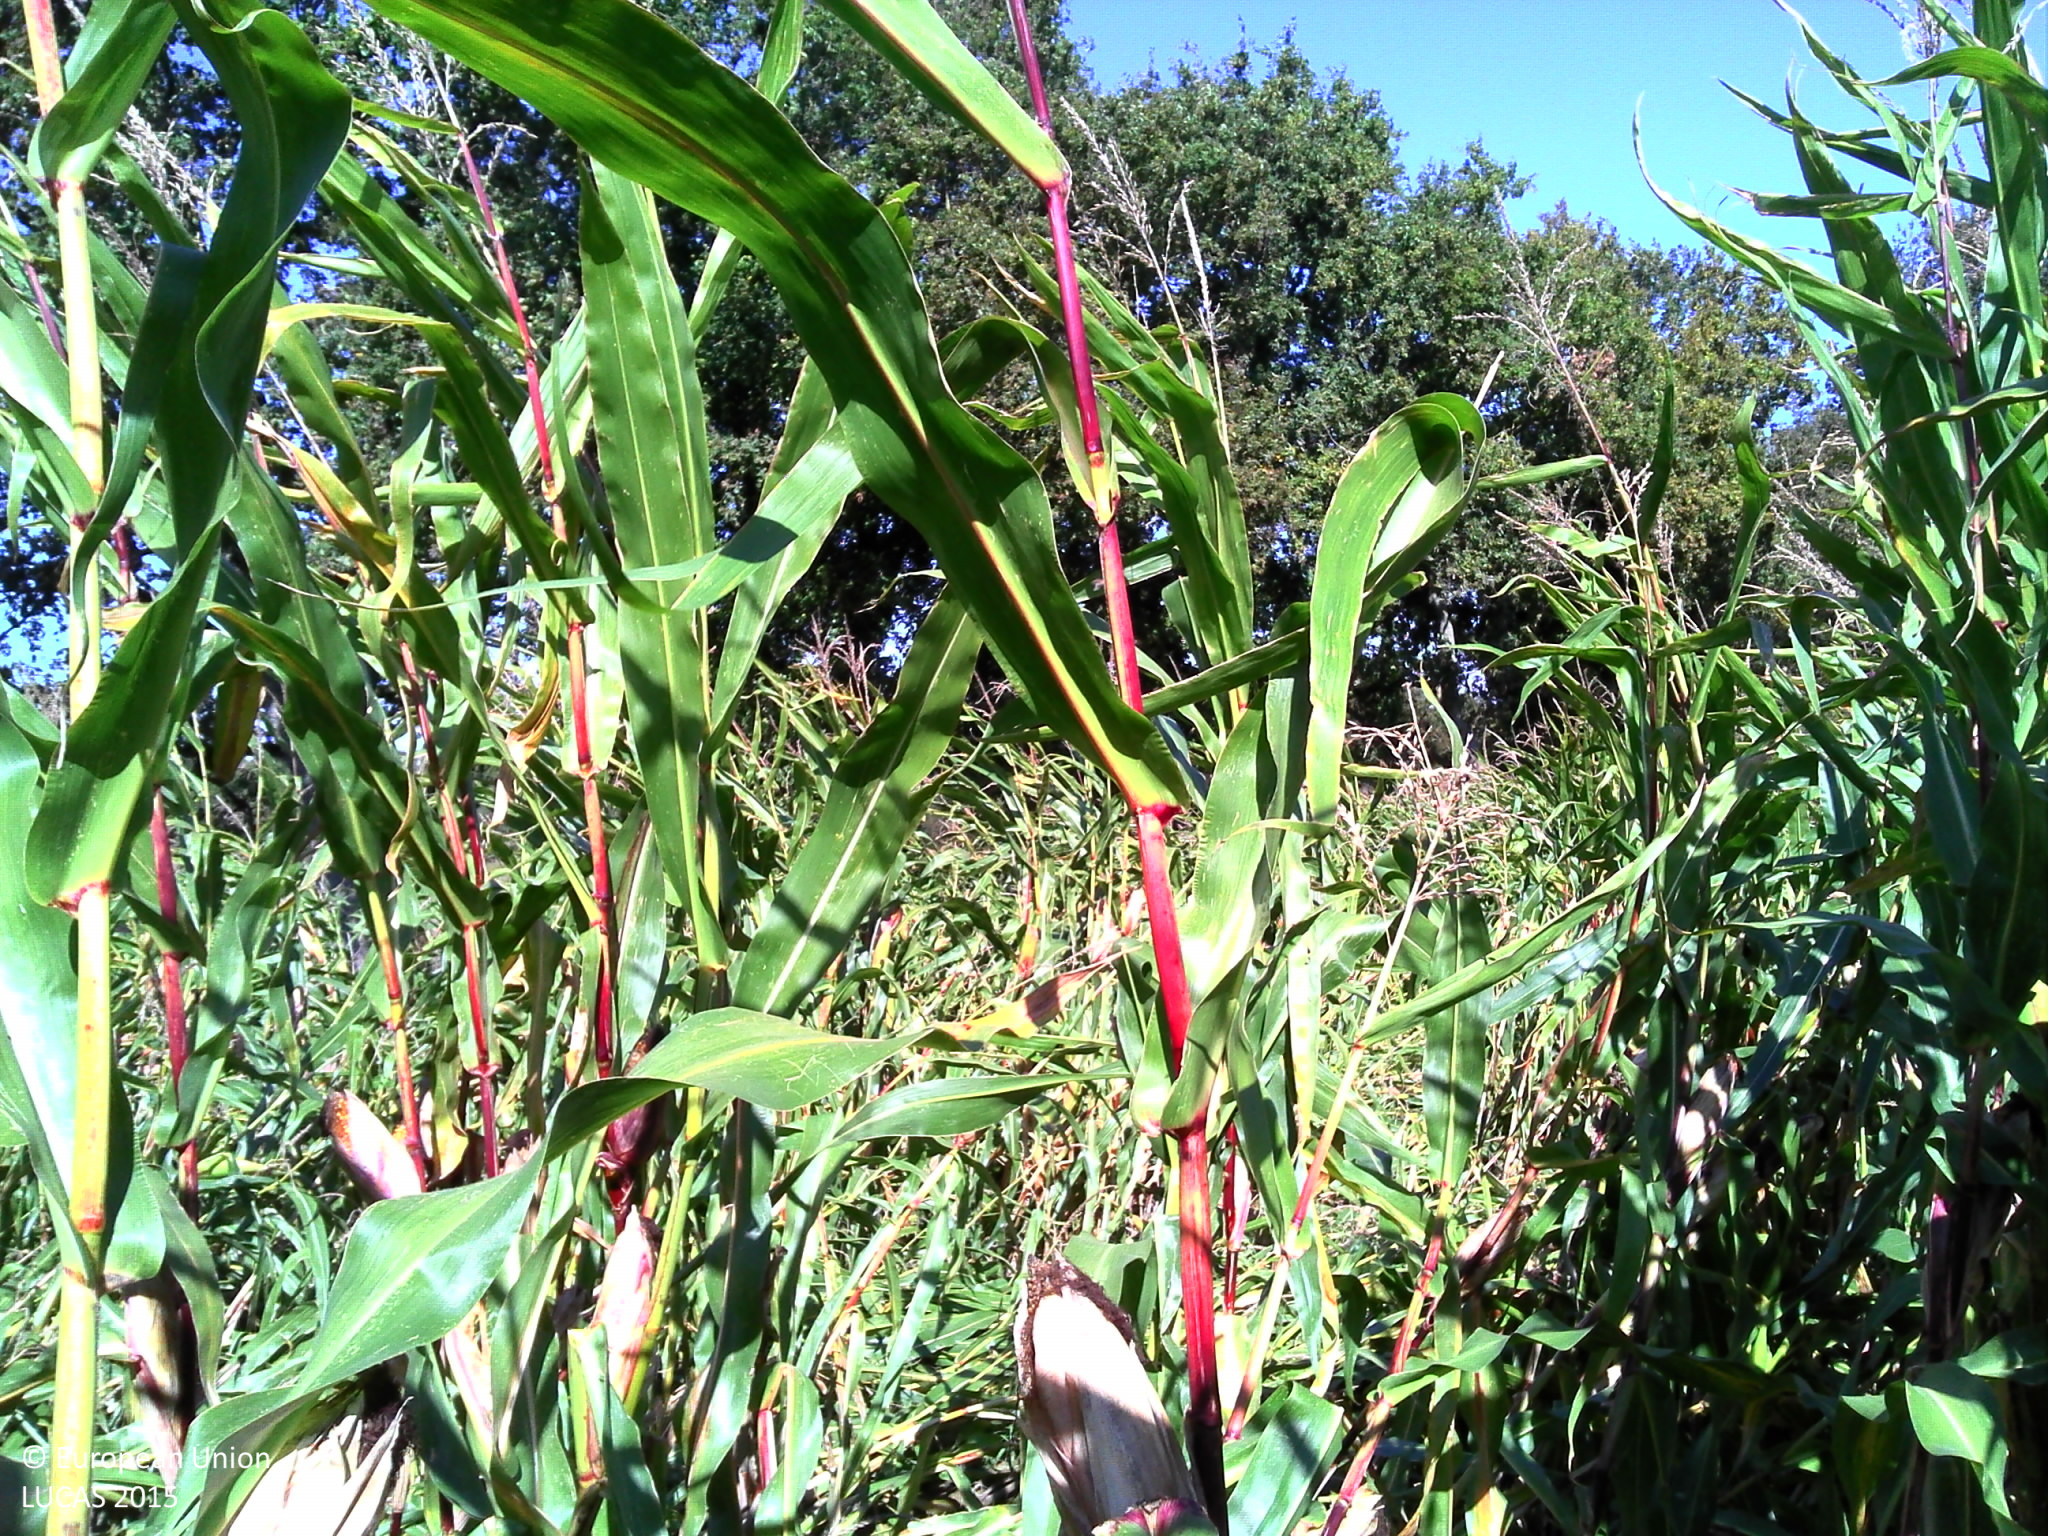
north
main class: Cropland
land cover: Maize
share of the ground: > 75 %
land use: Agriculture (excluding fallow land and kitchen gardens)
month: September
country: FR
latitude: 46.5839
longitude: -1.3246
